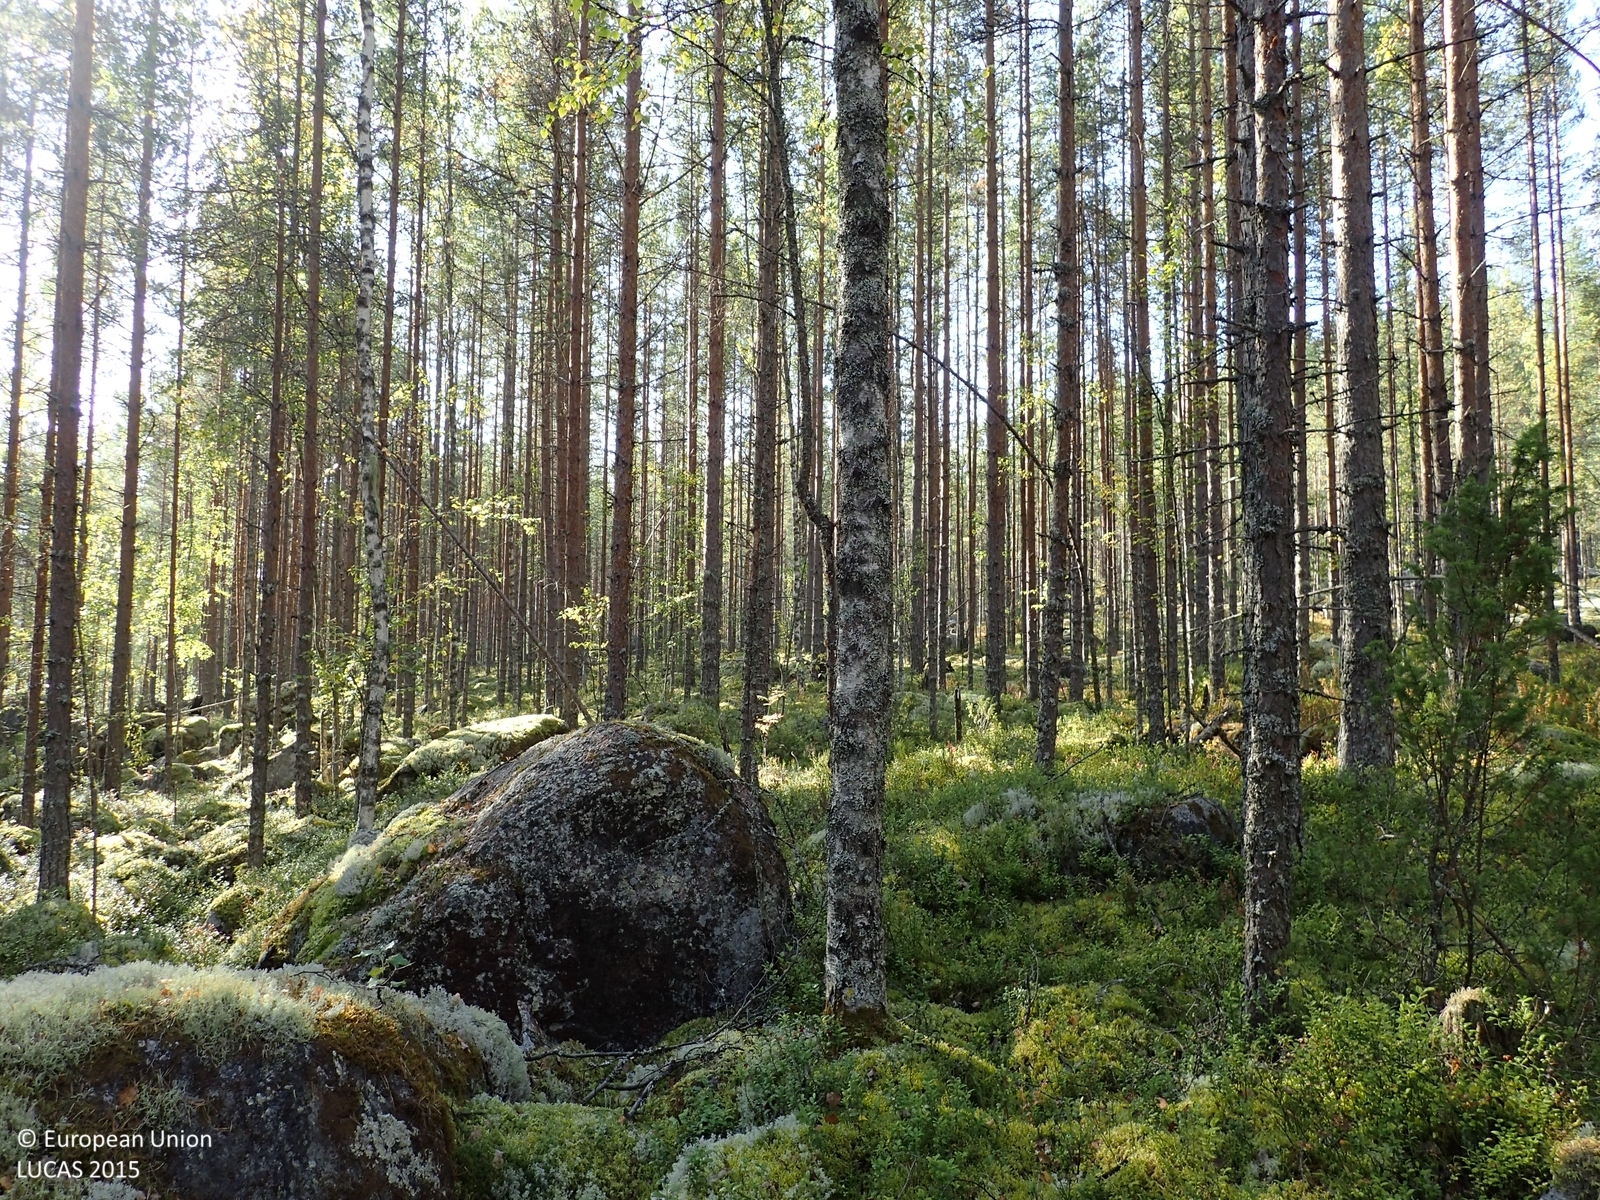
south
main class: Woodland
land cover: Pine dominated coniferous woodland
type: boreal forest
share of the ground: > 75 %
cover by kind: coniferous forest trees 65 %, shrubs 15 %, broadleaved forest trees 10 %, lichens and mosses 5 %, consolidated bare surface 5 %
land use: Forestry
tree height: > 5 m
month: September
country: FI
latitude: 62.9310
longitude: 25.2891
